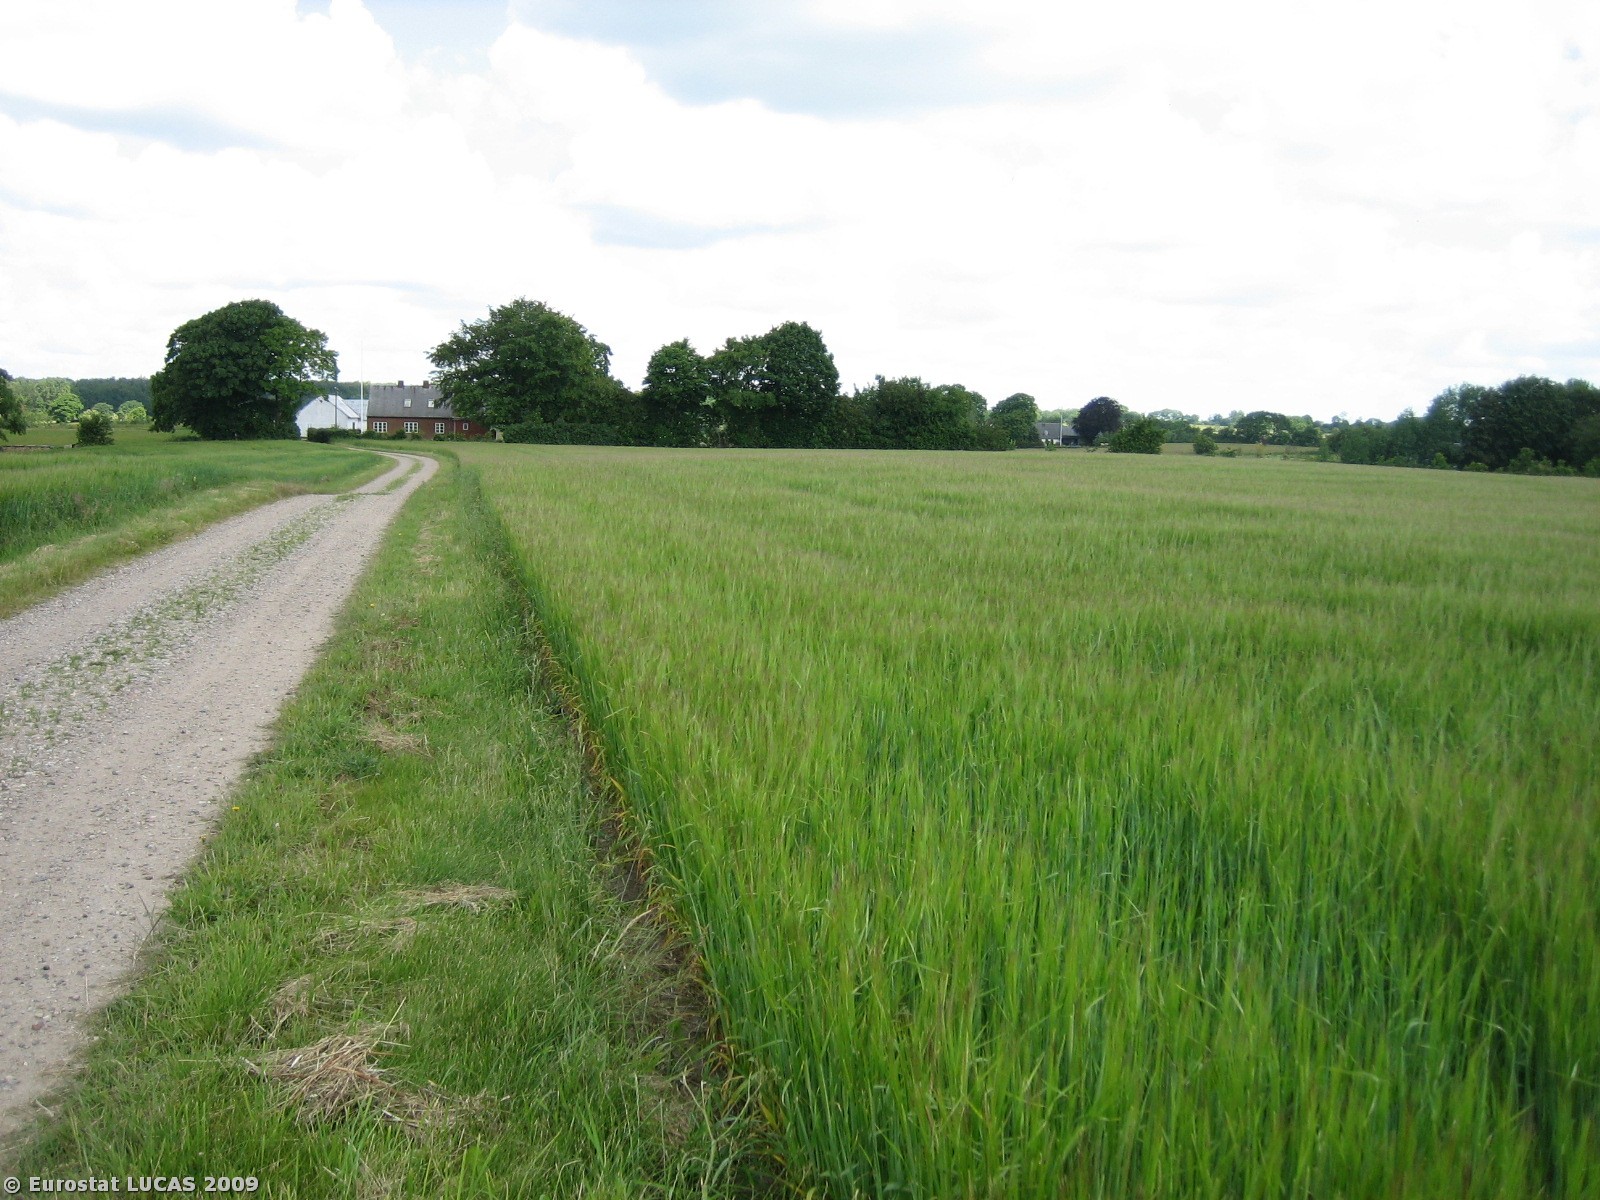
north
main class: Cropland
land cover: Barley
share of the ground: > 75 %
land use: Agriculture (excluding fallow land and kitchen gardens)
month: June
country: DK
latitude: 55.5566
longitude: 9.2873
